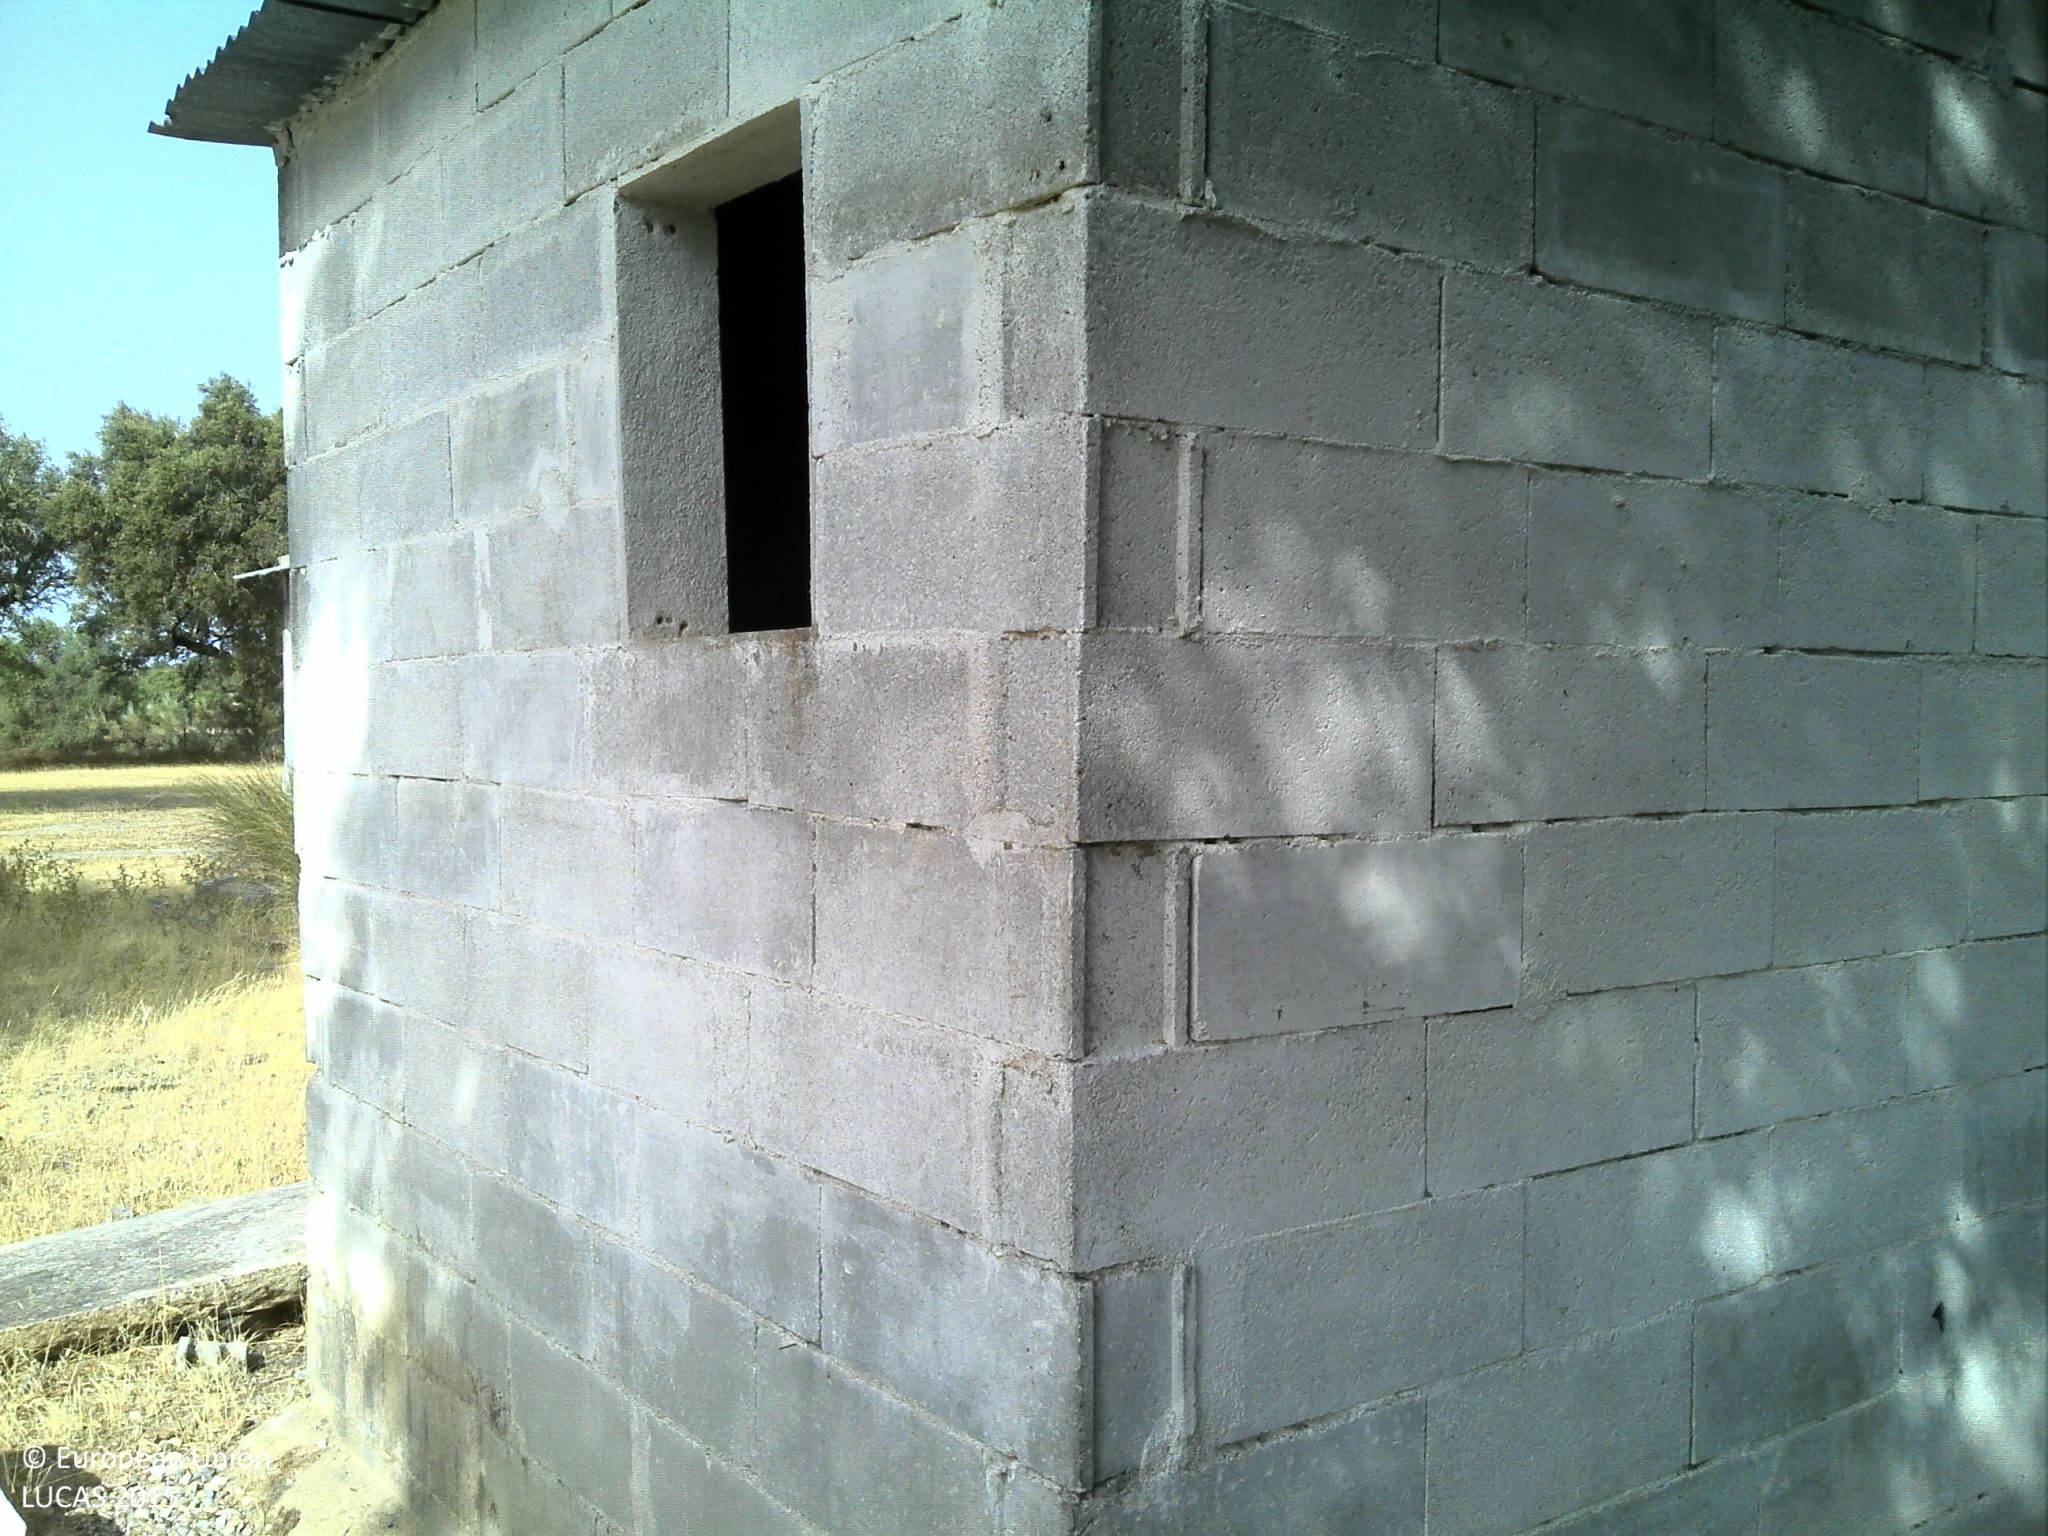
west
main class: Woodland
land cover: Broadleaved woodland
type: broadleaved evergreen forest
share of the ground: 10 - 25 %
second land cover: Grassland without tree/shrub cover
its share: 10 - 25 %
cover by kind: unconsolidated bare surface 80 %, broadleaved forest trees 10 %, herbaceous plants 10 %
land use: Forestry
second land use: Agriculture (excluding fallow land and kitchen gardens)
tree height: > 5 m
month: July
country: PT
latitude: 38.7197
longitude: -7.7861
